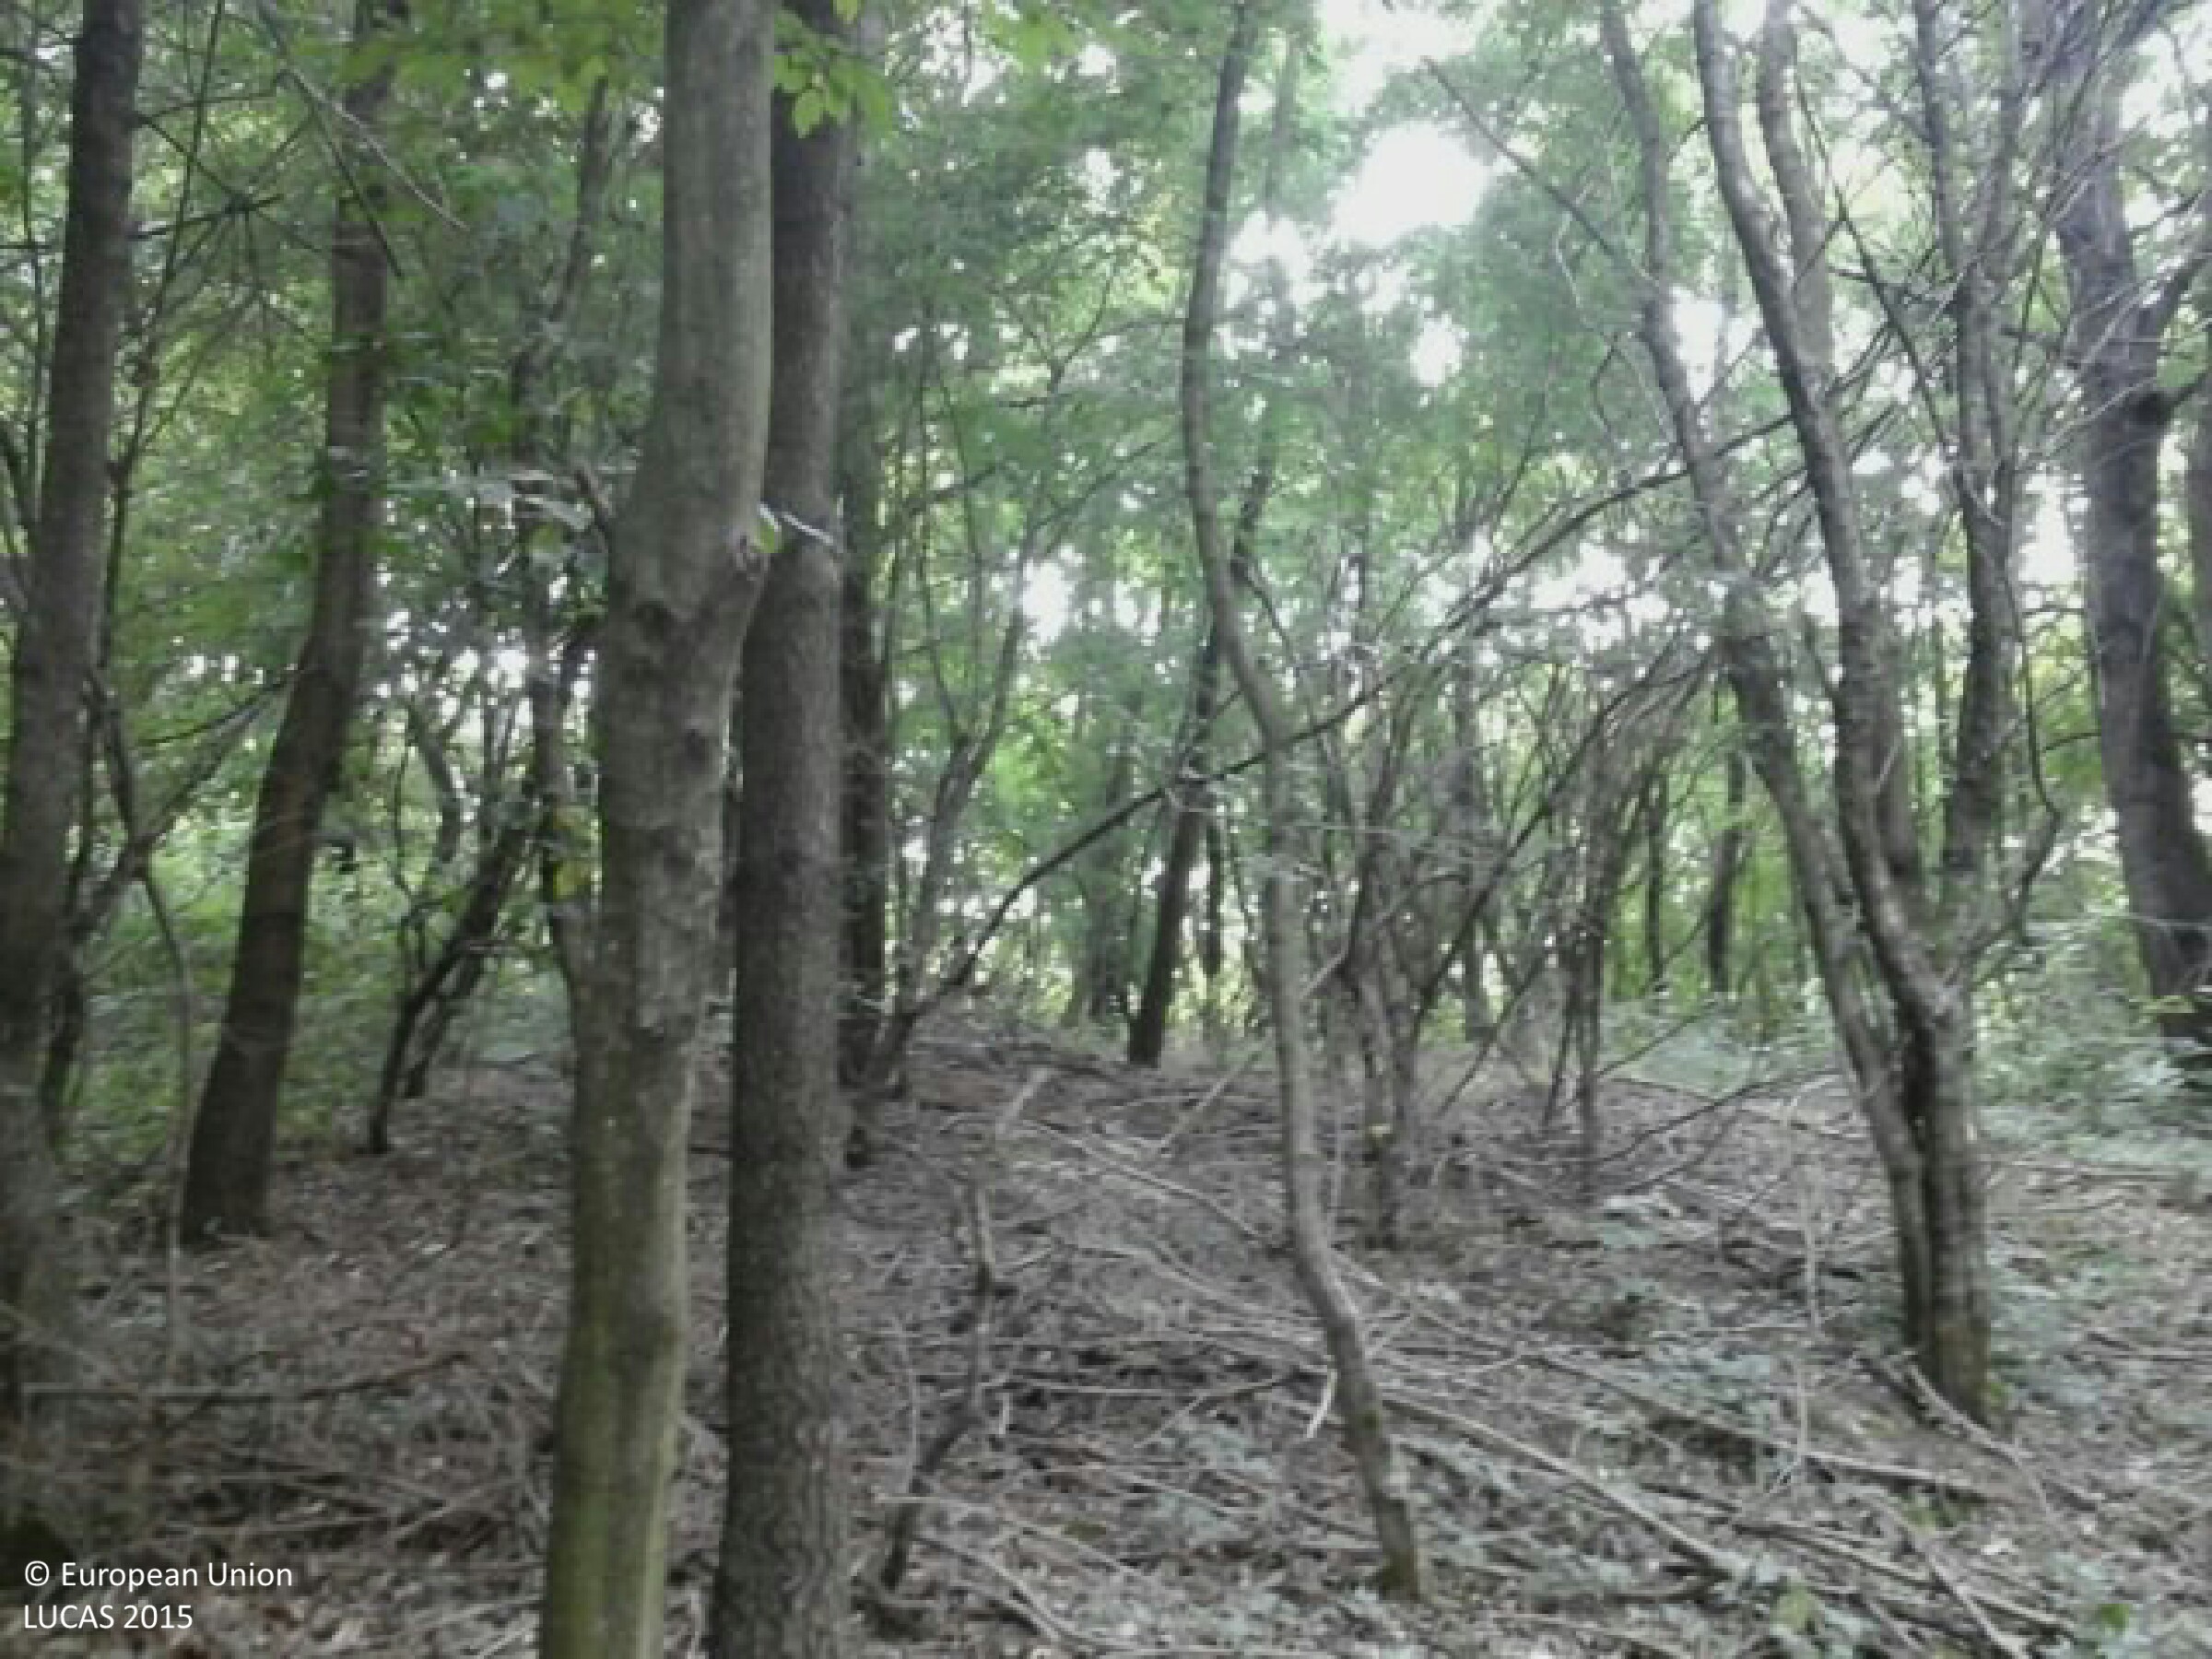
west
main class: Woodland
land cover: Broadleaved woodland
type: mesophytic deciduous forest
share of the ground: > 75 %
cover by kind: broadleaved forest trees 90 %, shrubs 10 %
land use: Forestry
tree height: > 5 m
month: August
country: HU
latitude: 46.4752
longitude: 17.3892
